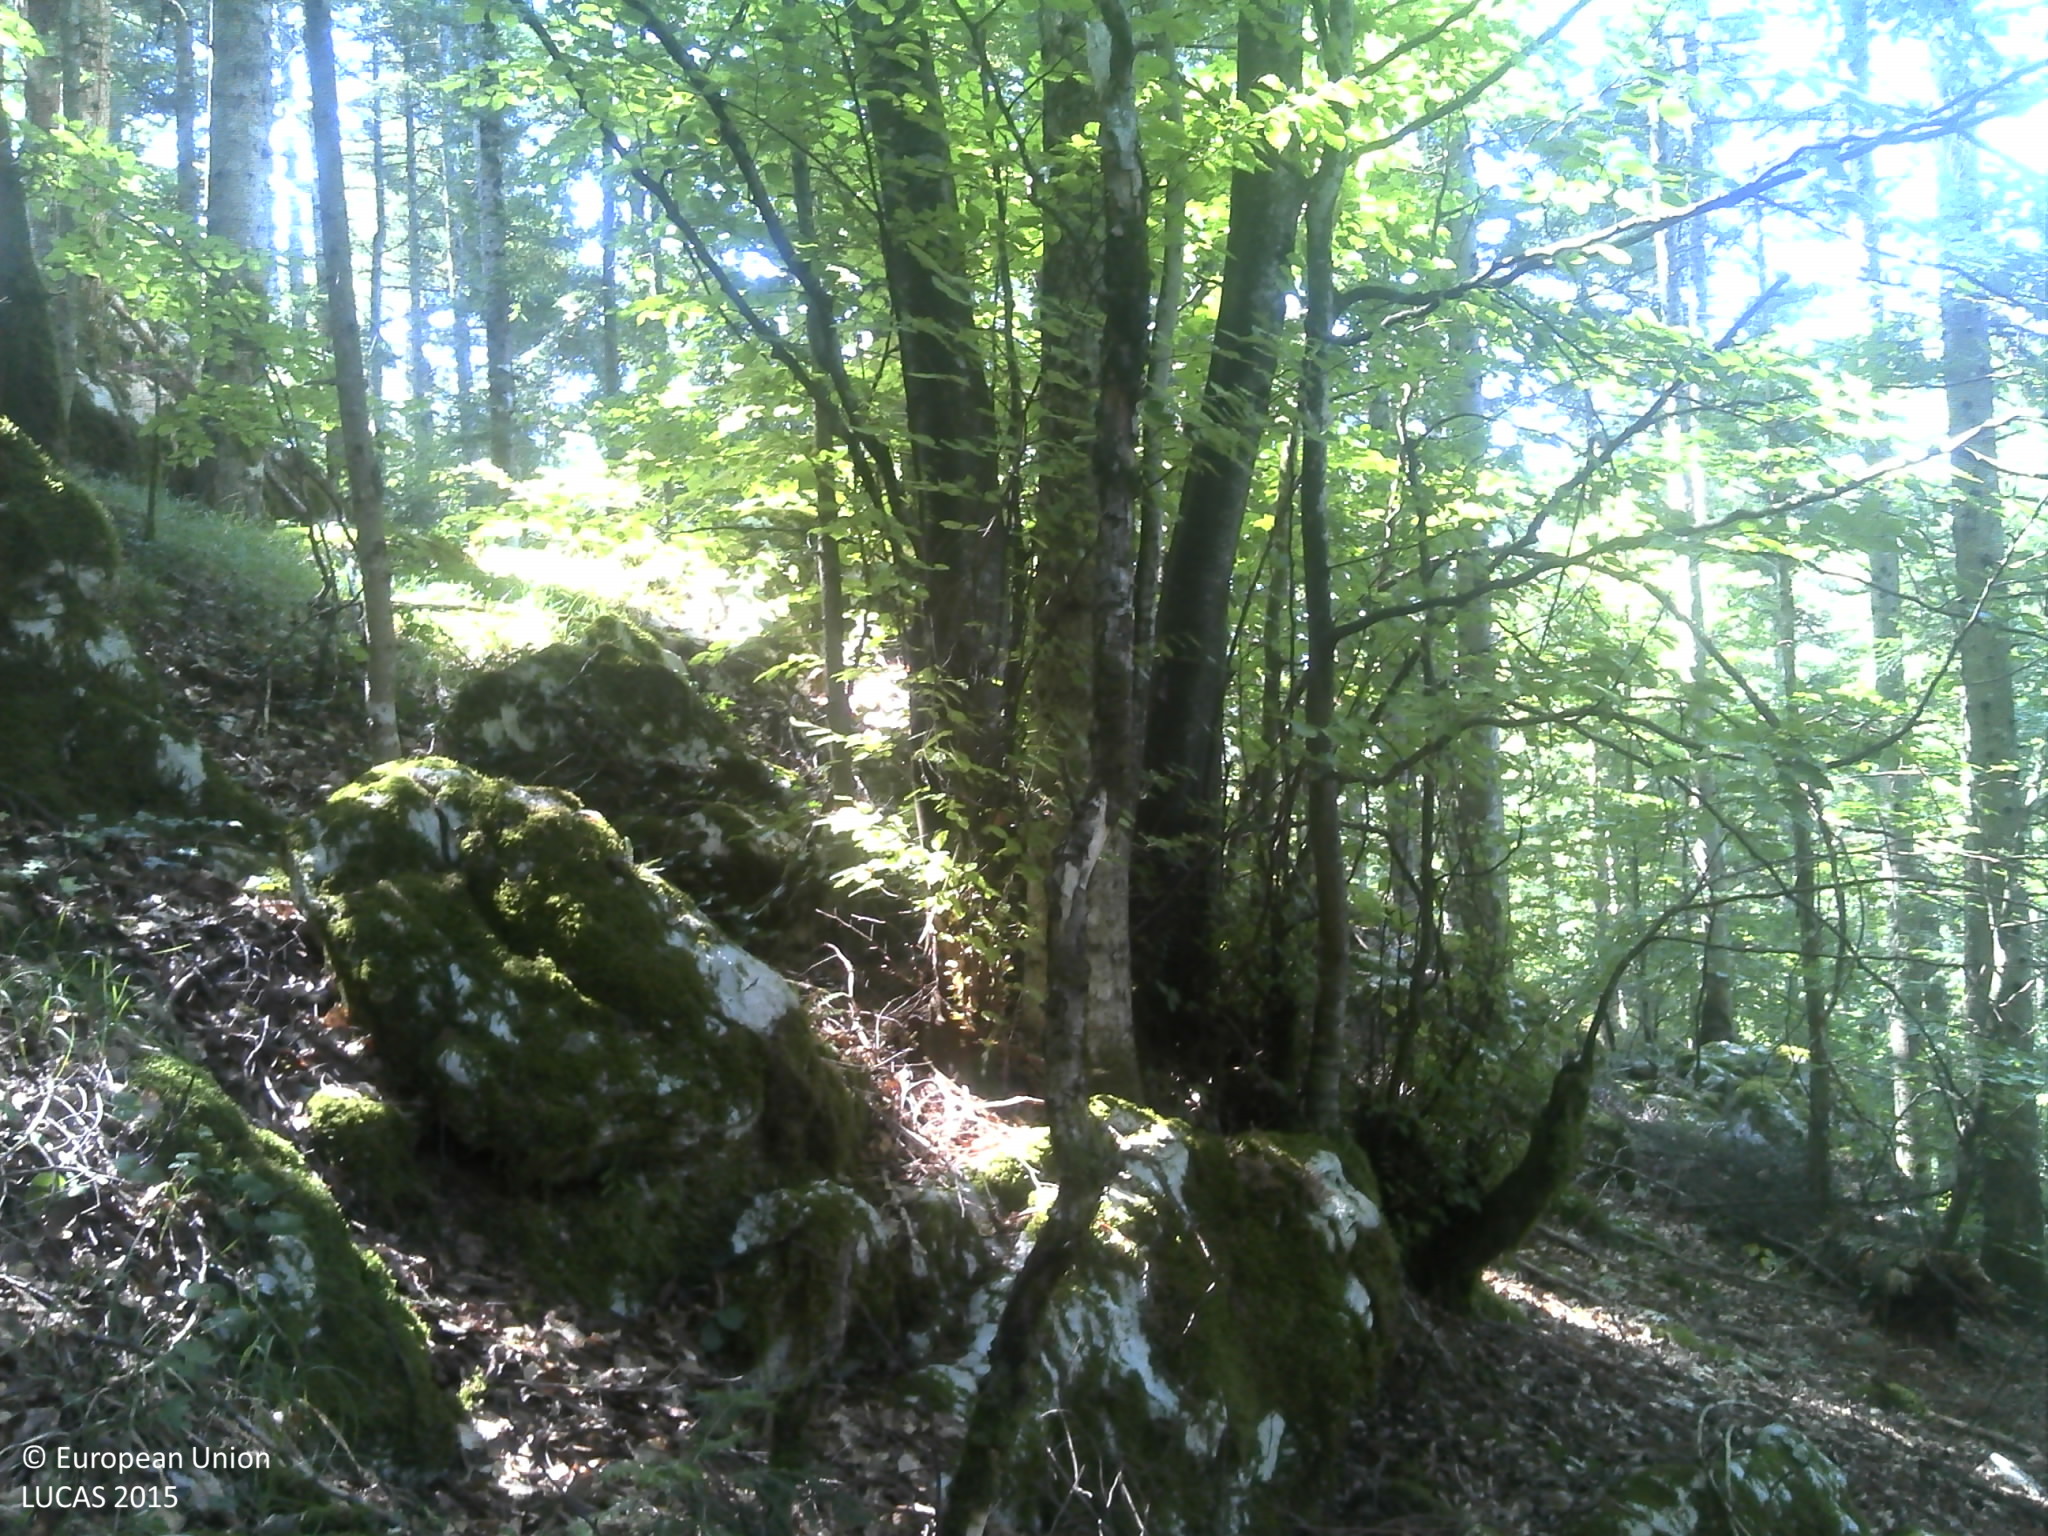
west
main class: Woodland
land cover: Other mixed woodland
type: beech forest
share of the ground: > 75 %
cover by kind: broadleaved forest trees 55 %, coniferous forest trees 30 %, lichens and mosses 5 %, consolidated bare surface 5 %, unconsolidated bare surface 5 %
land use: Forestry
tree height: > 5 m
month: August
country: HR
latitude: 44.7052
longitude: 15.2568
